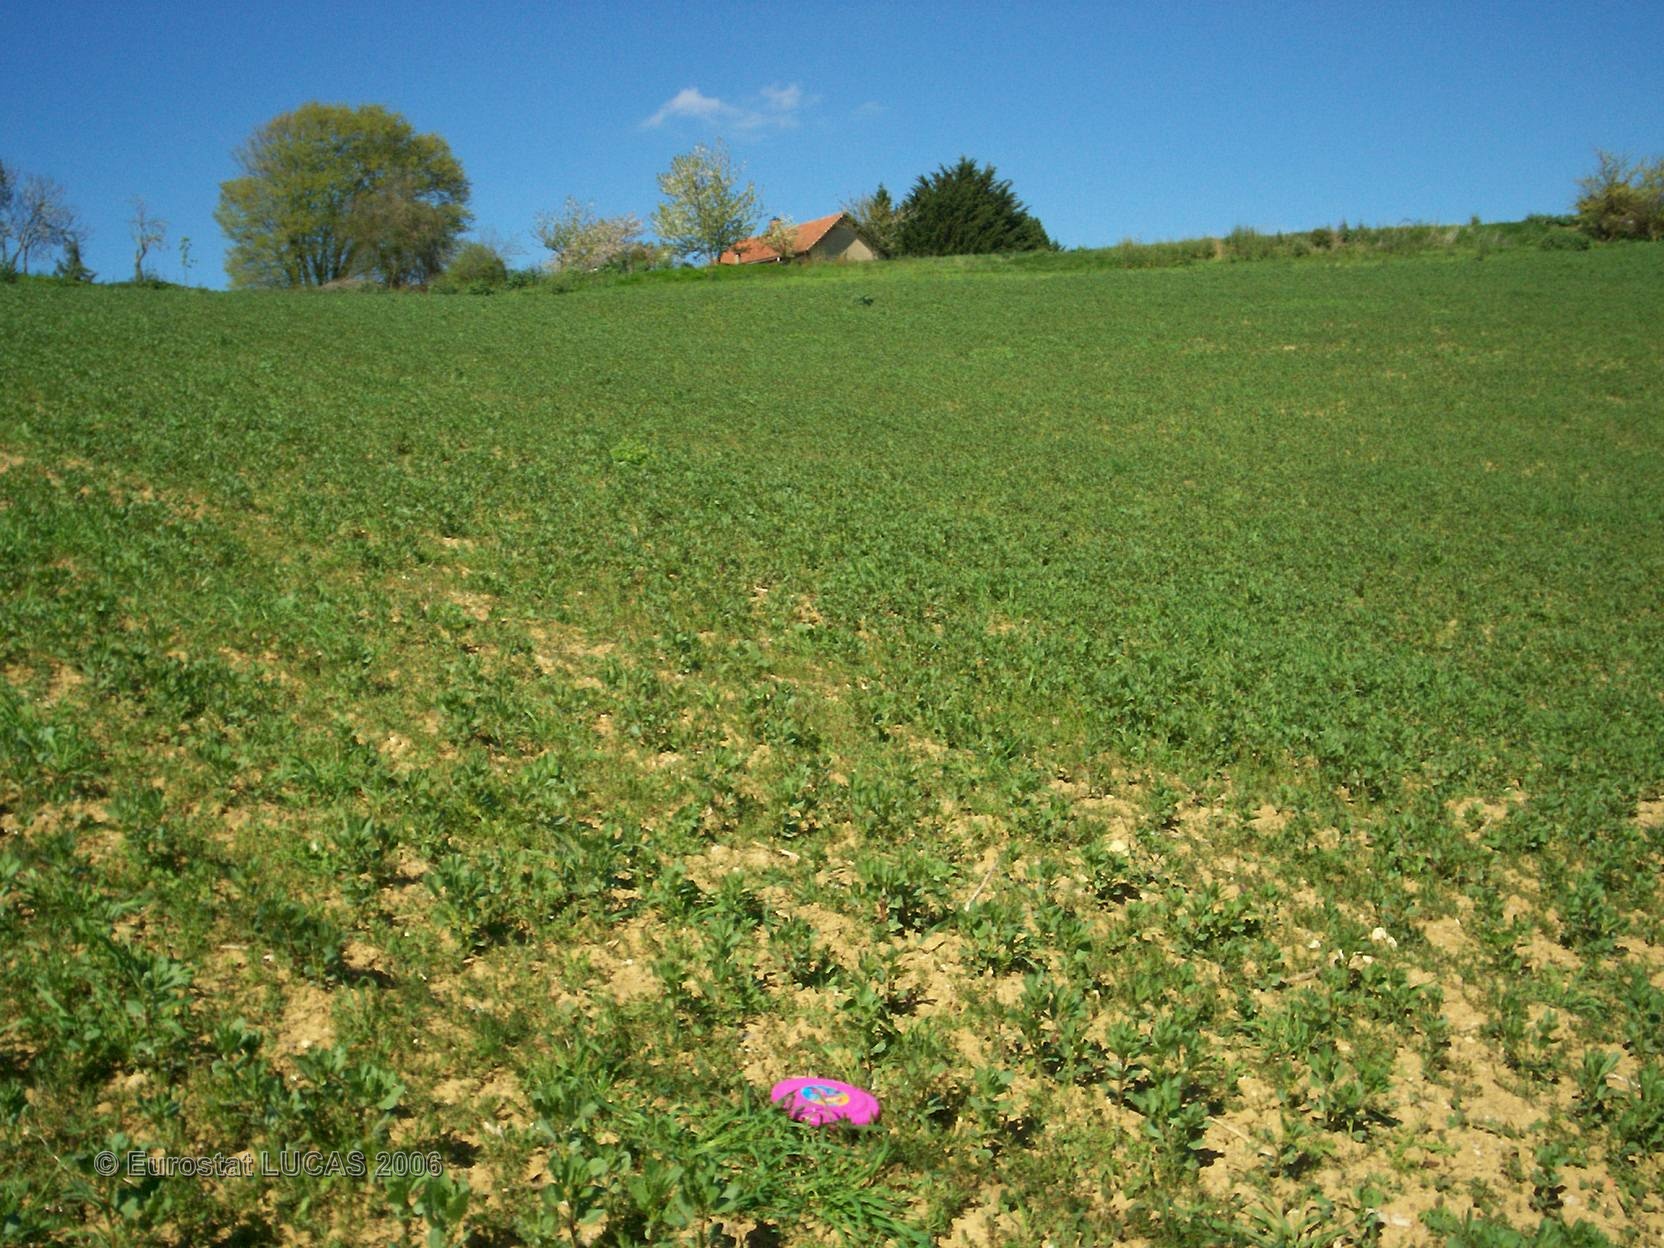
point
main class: Cropland
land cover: Dry pulses
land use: Agriculture (excluding fallow land and kitchen gardens)
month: April
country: FR
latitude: 43.5436
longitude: 0.2311
